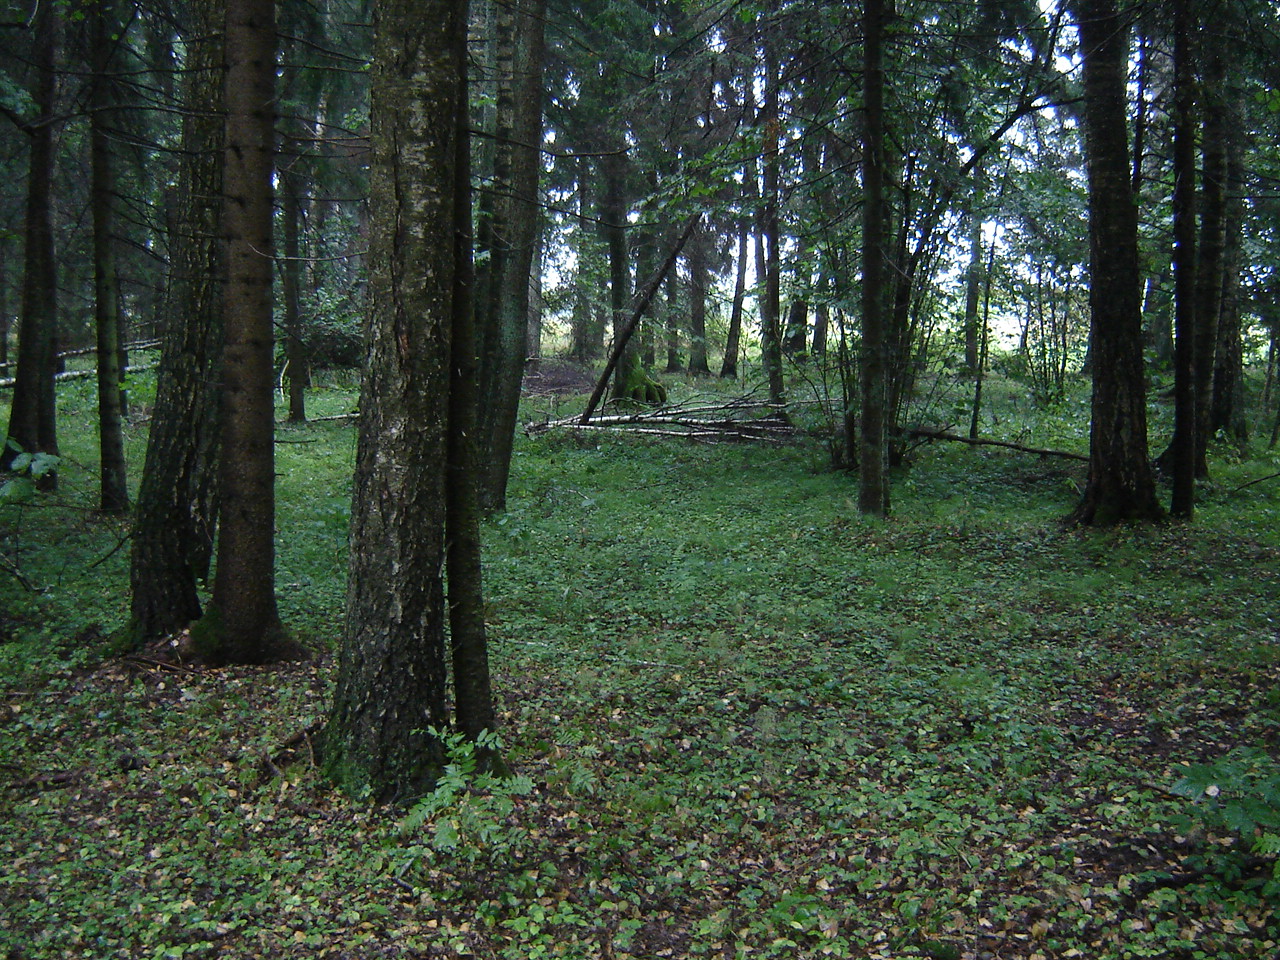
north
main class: Woodland
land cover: Spruce dominated mixed woodland
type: hemiboreal forest and nemoral coniferous forest and mixed broadleaved-coniferous forest
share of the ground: > 75 %
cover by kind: coniferous forest trees 60 %, broadleaved forest trees 30 %, herbaceous plants 5 %, unconsolidated bare surface 5 %
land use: Forestry
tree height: > 5 m
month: September
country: LT
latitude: 54.4448
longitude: 25.0905
